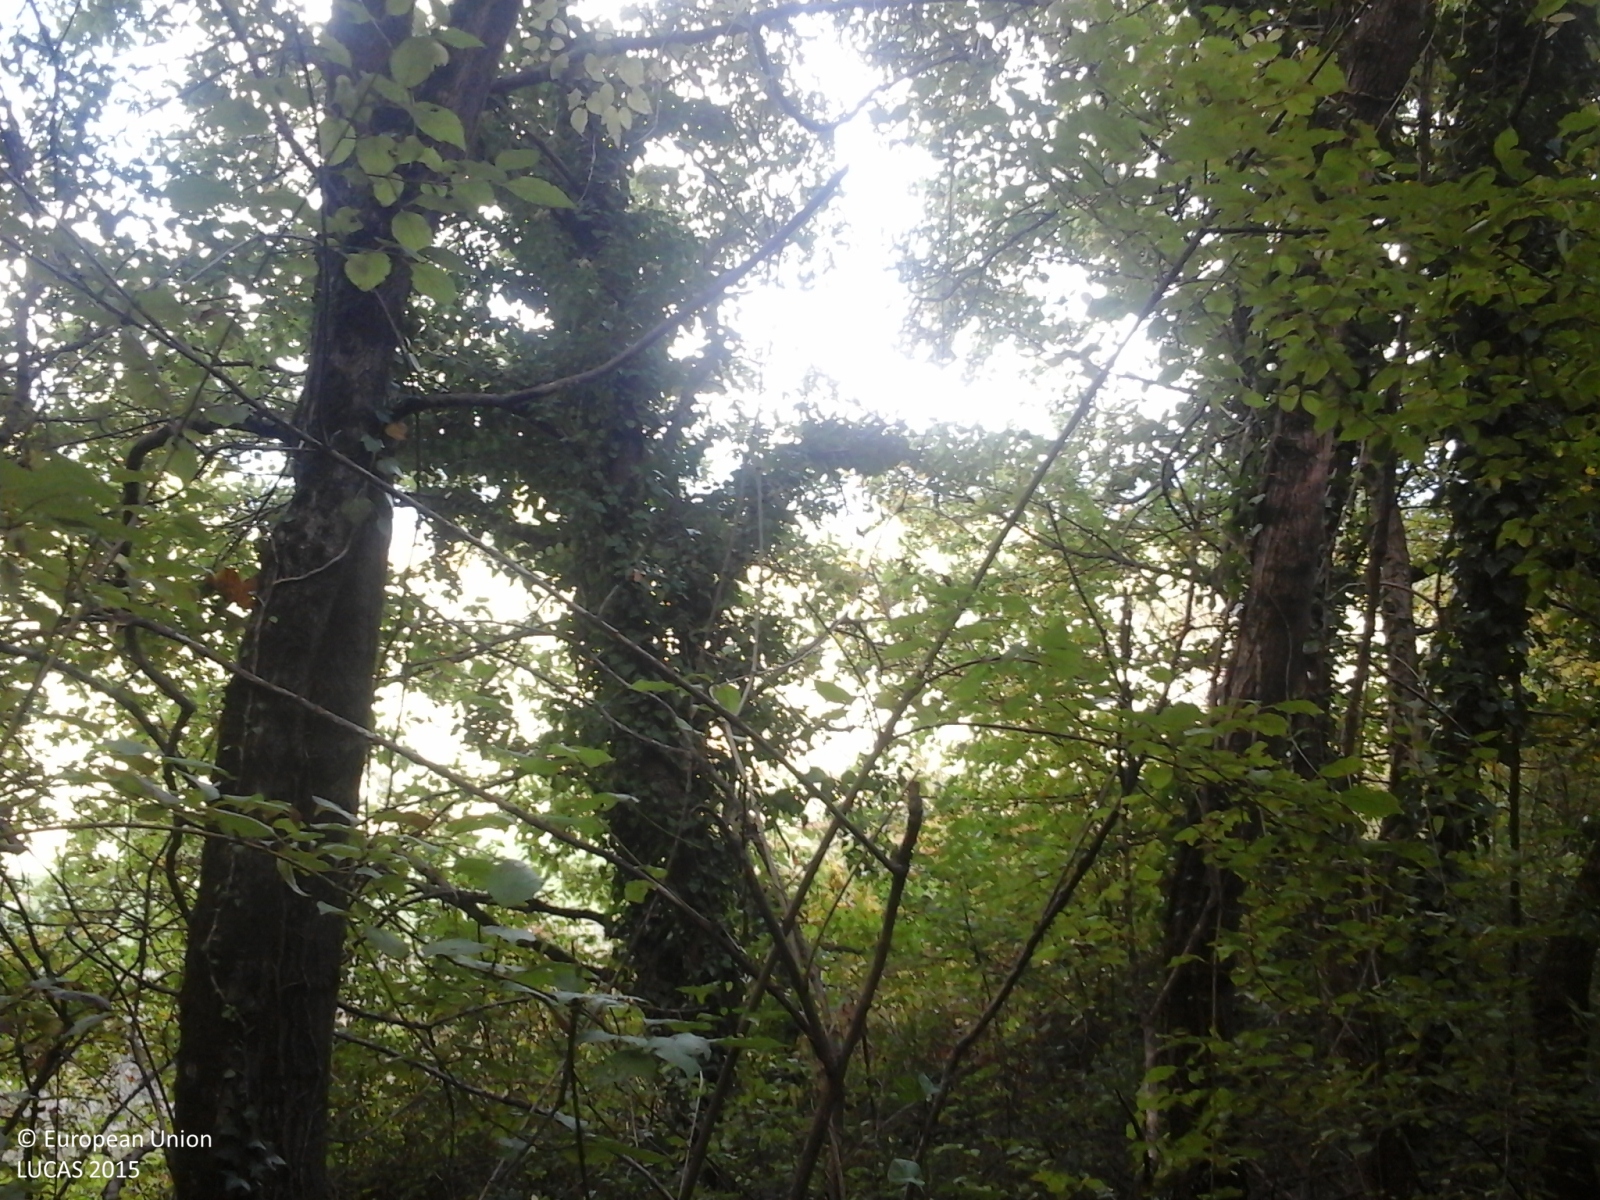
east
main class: Woodland
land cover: Broadleaved woodland
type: thermophilous deciduous forest
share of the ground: > 75 %
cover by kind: broadleaved forest trees 70 %, shrubs 30 %
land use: Forestry
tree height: > 5 m
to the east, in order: Broadleaved woodland; Fences; Olive groves; Other fresh vegetables; Other fruit trees and berries; Fences; Abandoned hedges; Tracks; Broadleaved woodland; Electric lines; Spontaneously vegetated surfaces; Abandoned hedges; Fences; Ditches and canals; Inland marshes
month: October
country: IT
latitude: 43.4247
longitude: 12.2050
